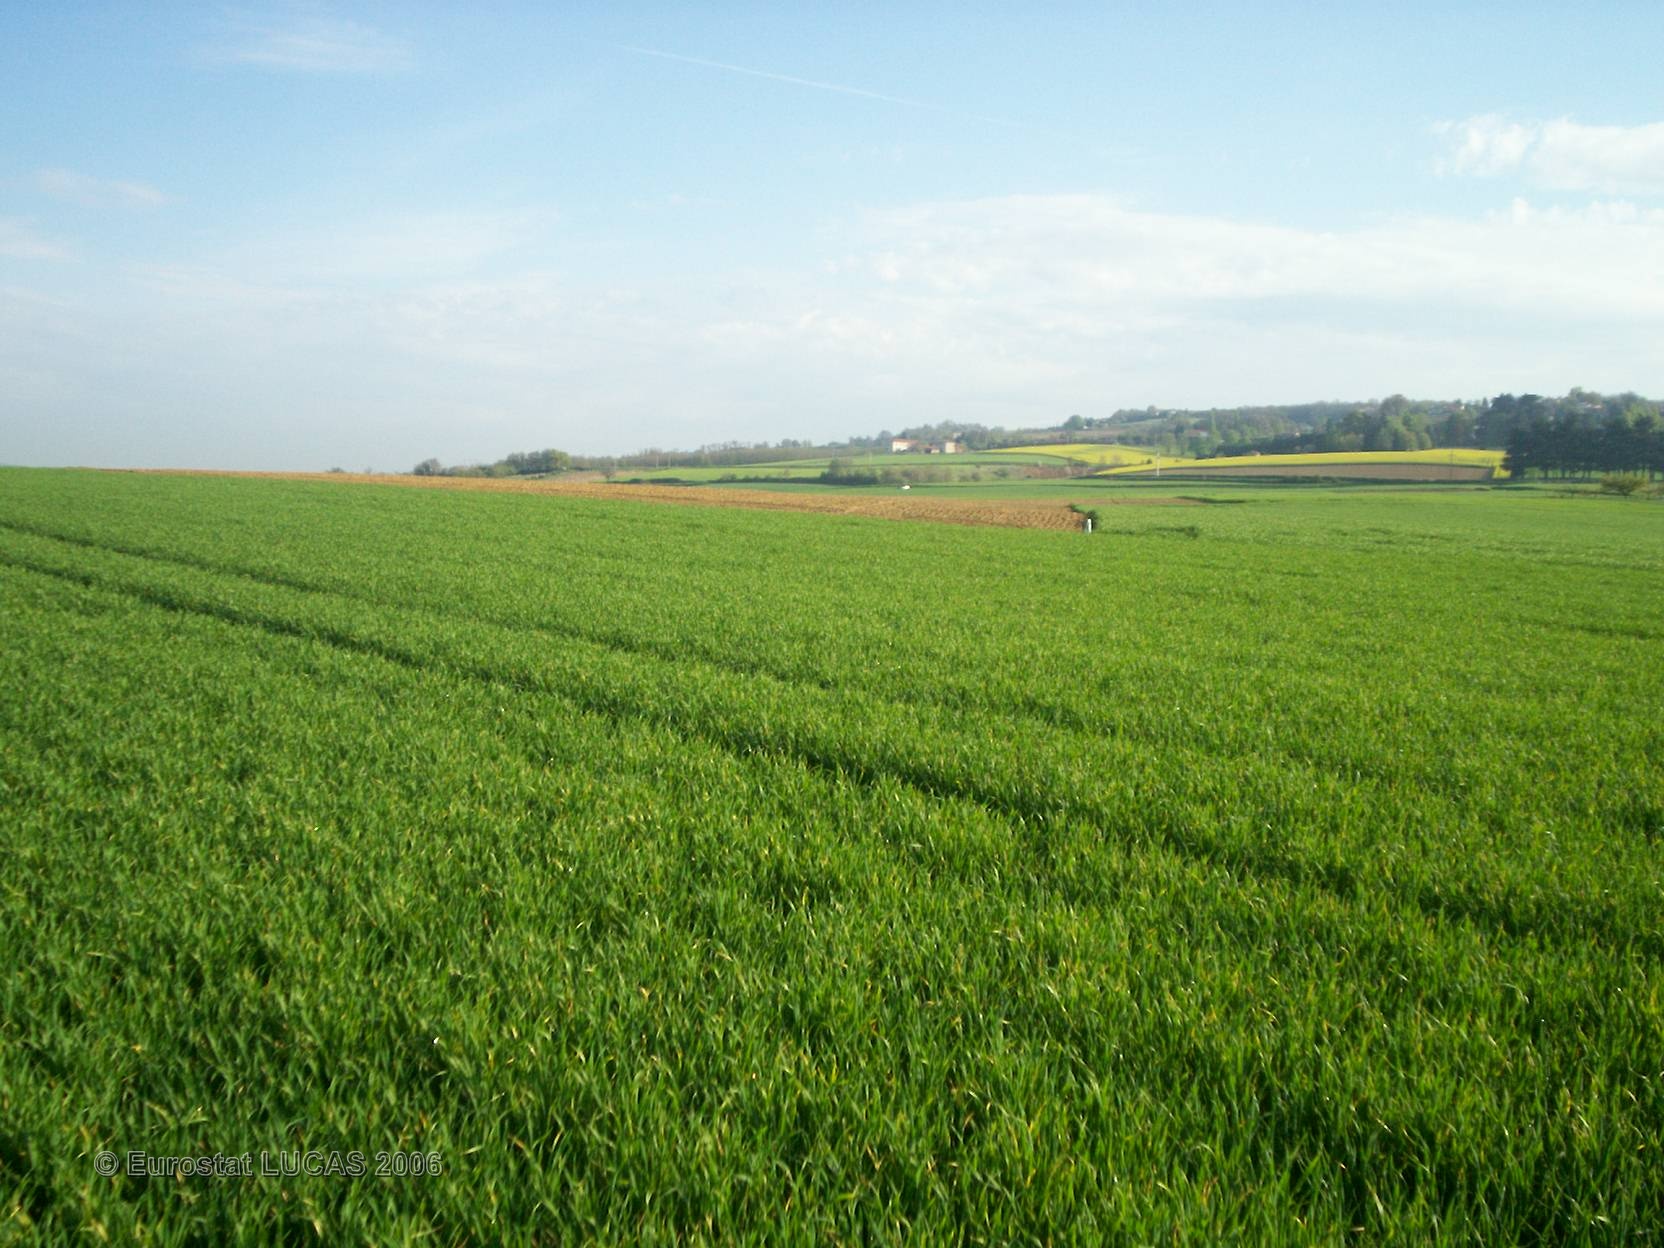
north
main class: Cropland
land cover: Common wheat
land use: Agriculture (excluding fallow land and kitchen gardens)
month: April
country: FR
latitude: 45.4510
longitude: 4.8513
